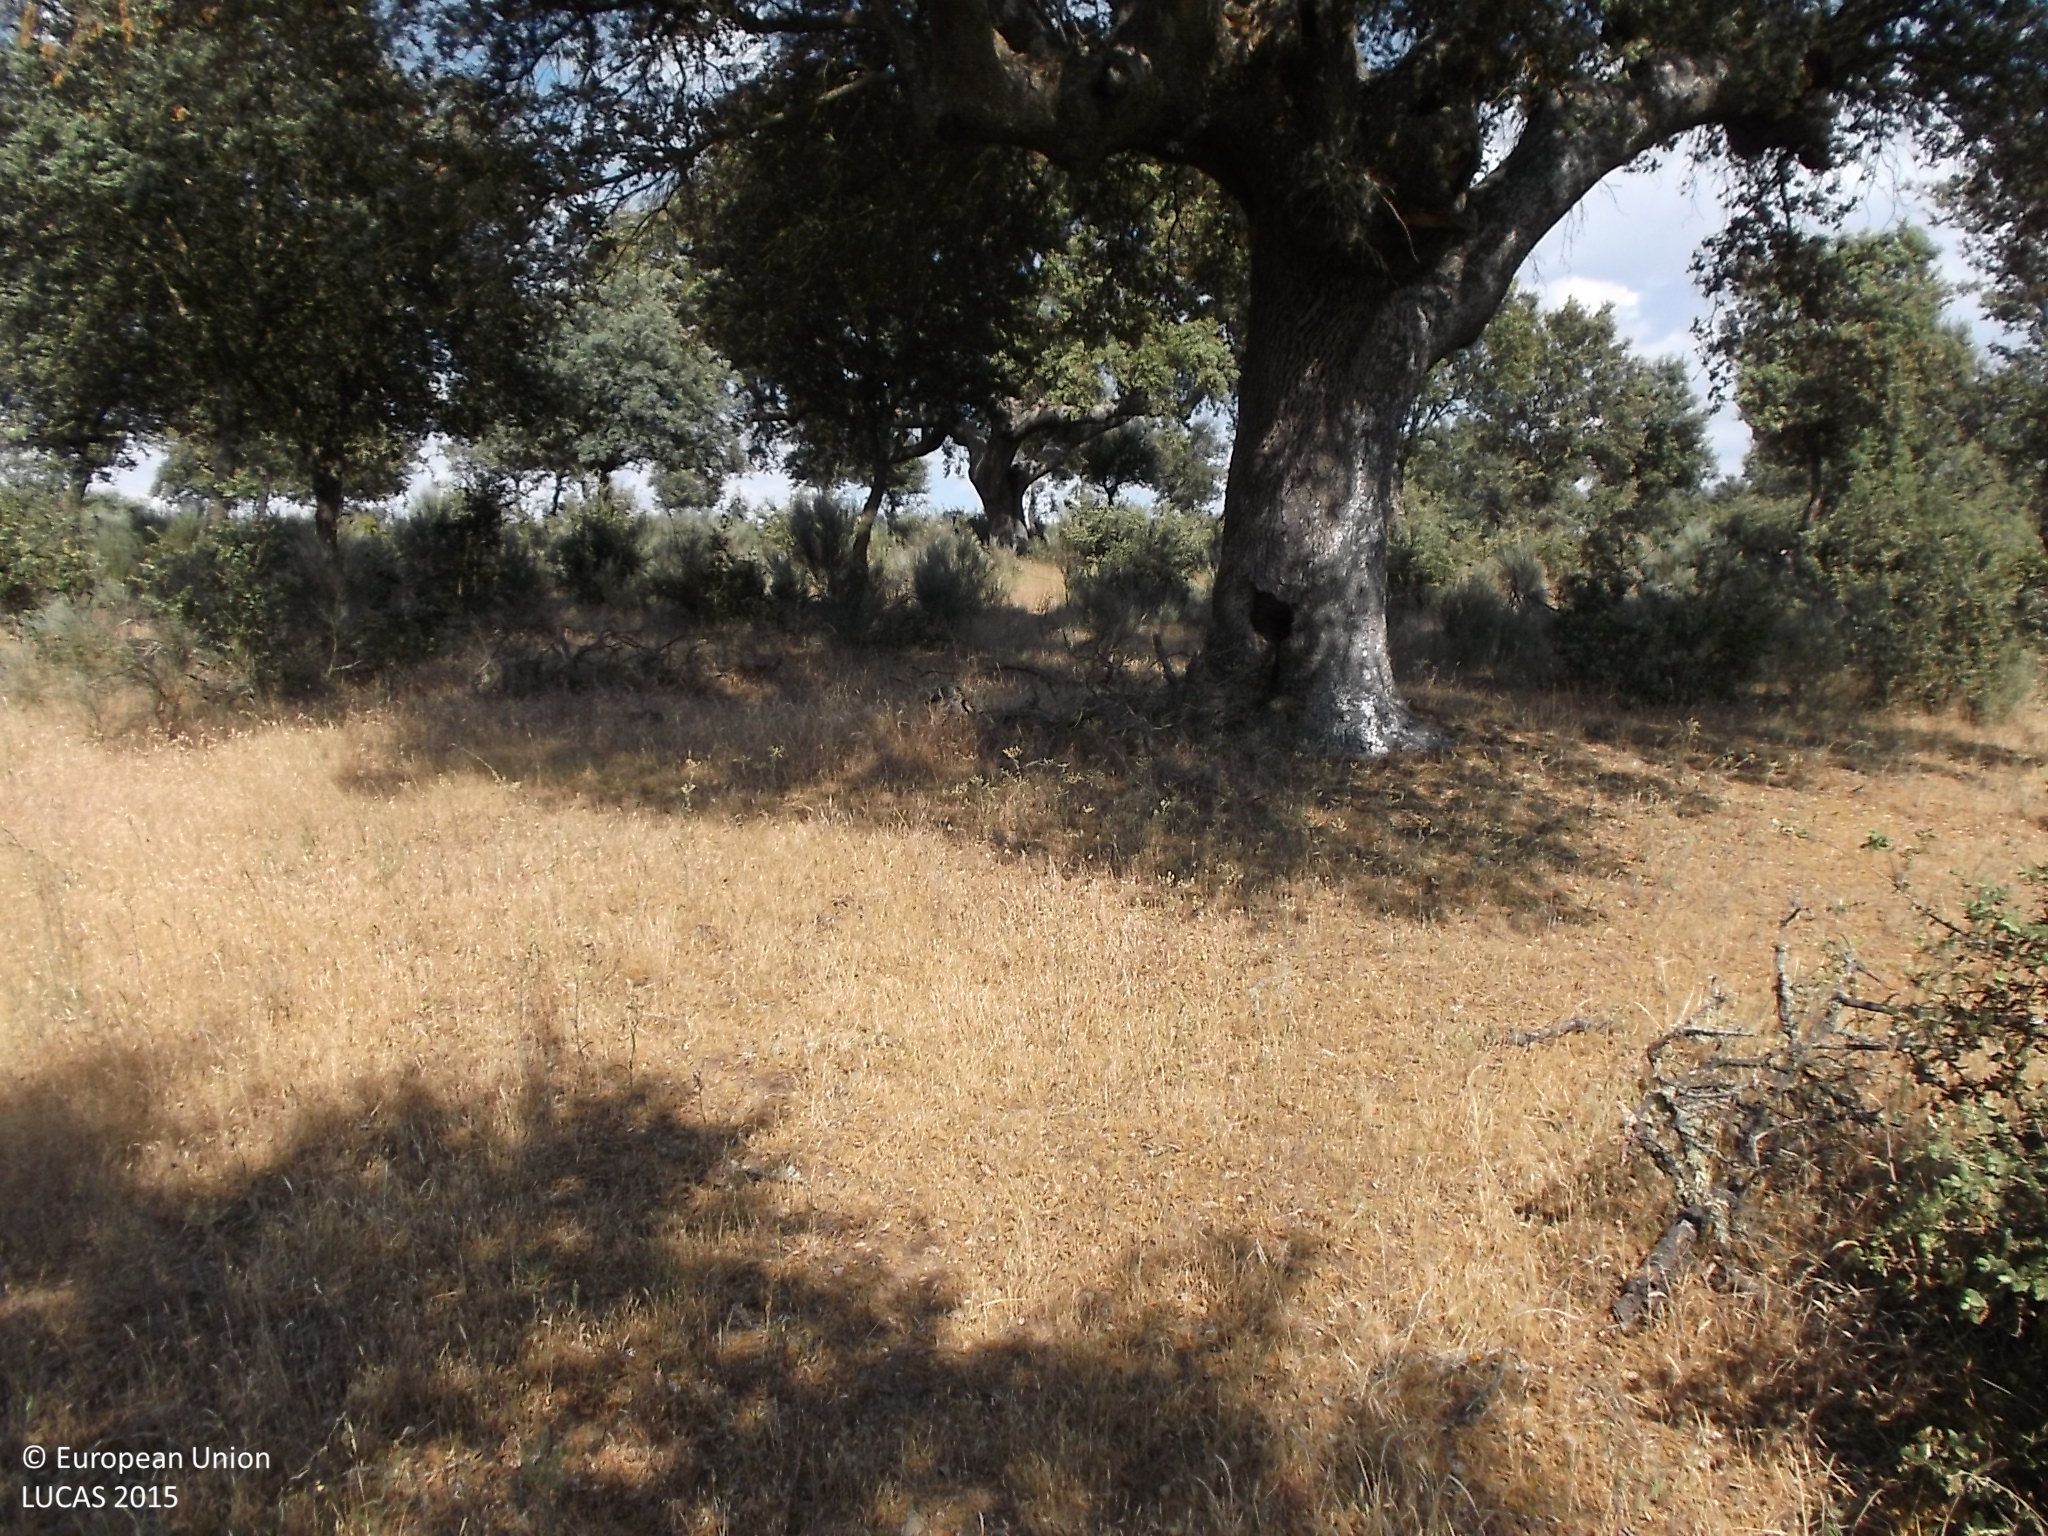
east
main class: Woodland
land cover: Broadleaved woodland
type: thermophilous deciduous forest
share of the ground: 10 - 25 %
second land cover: Shrubland without tree cover
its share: 50 - 75 %
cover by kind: shrubs 50 %, herbaceous plants 35 %, broadleaved forest trees 15 %
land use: Forestry
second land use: Agriculture (excluding fallow land and kitchen gardens)
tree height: > 5 m
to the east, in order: Broadleaved woodland; Shrubland without tree cover; Grassland without tree/shrub cover; Shrubland without tree cover
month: June
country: ES
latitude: 40.8604
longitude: -6.4276
